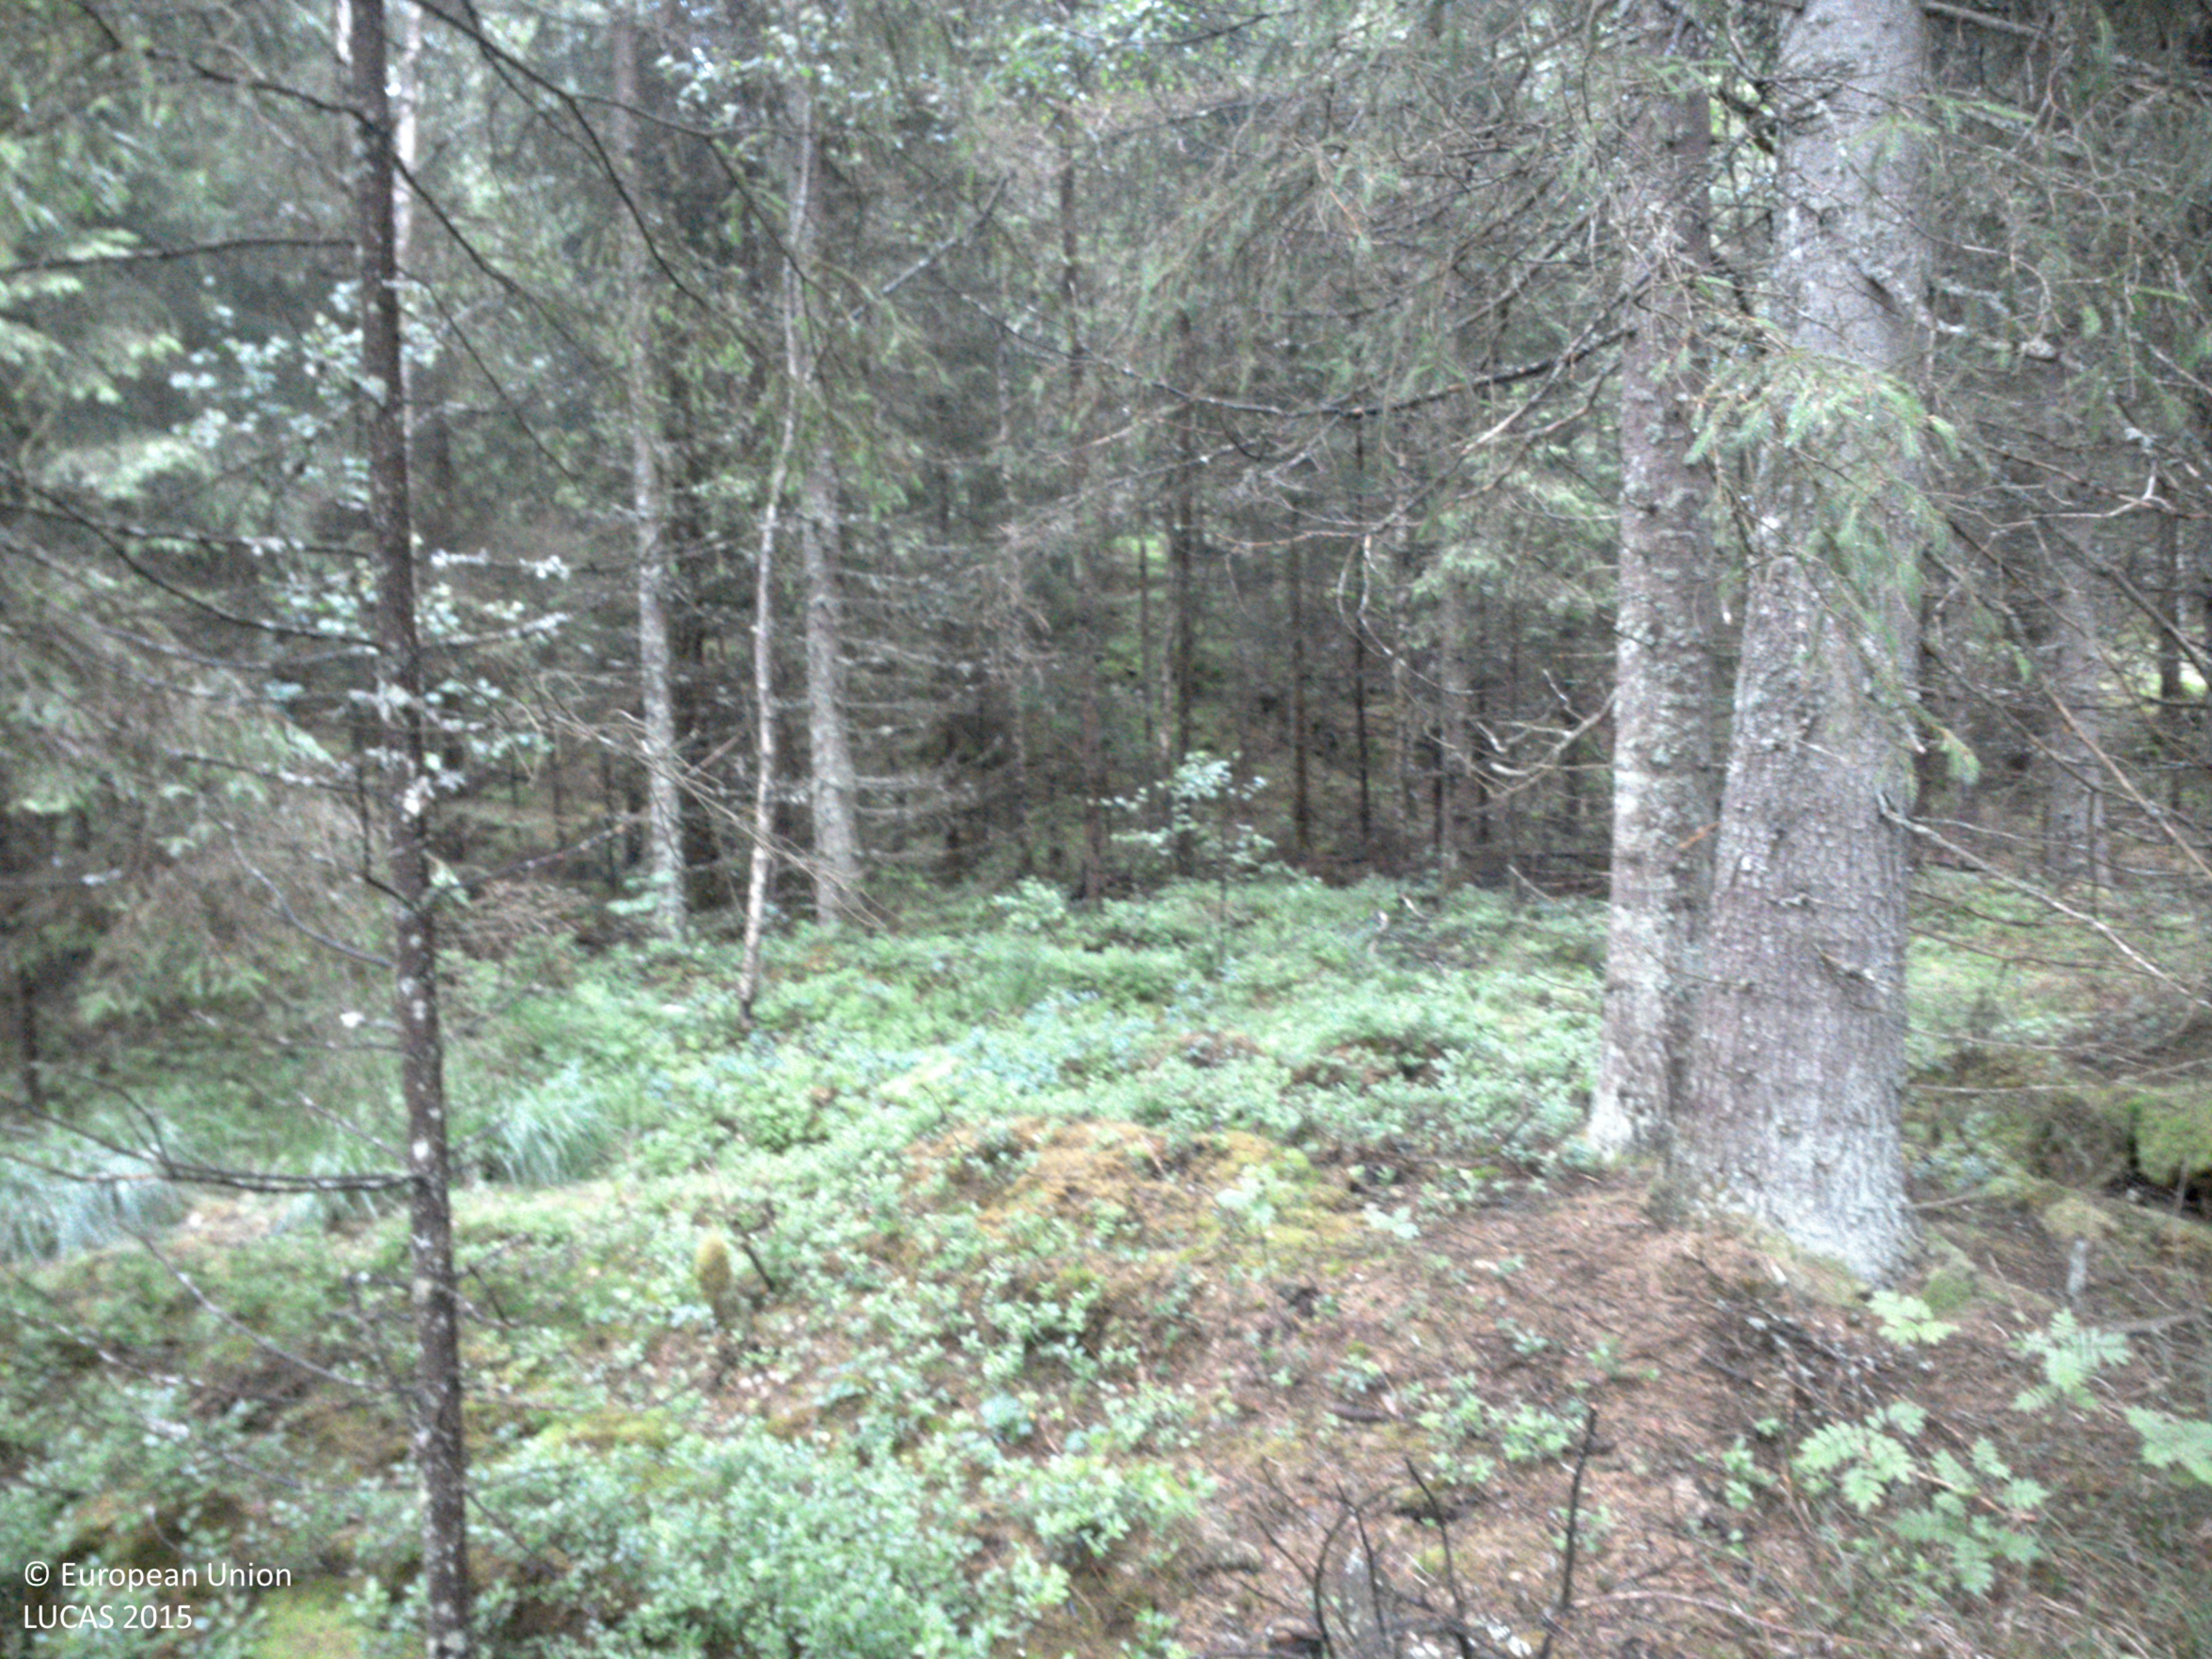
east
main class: Woodland
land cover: Spruce dominated mixed woodland
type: boreal forest
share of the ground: 50 - 75 %
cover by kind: coniferous forest trees 40 %, broadleaved forest trees 20 %, herbaceous plants 20 %, lichens and mosses 20 %
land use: Forestry
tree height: > 5 m
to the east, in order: Spruce dominated mixed woodland; Tracks; Spruce dominated mixed woodland; Tracks; Spruce dominated mixed woodland; Spruce dominated coniferous woodland; Spruce dominated mixed woodland; Rivers and streams; Grassland with sparse tree/shrub cover
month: July
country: SE
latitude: 58.7092
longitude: 11.9463
